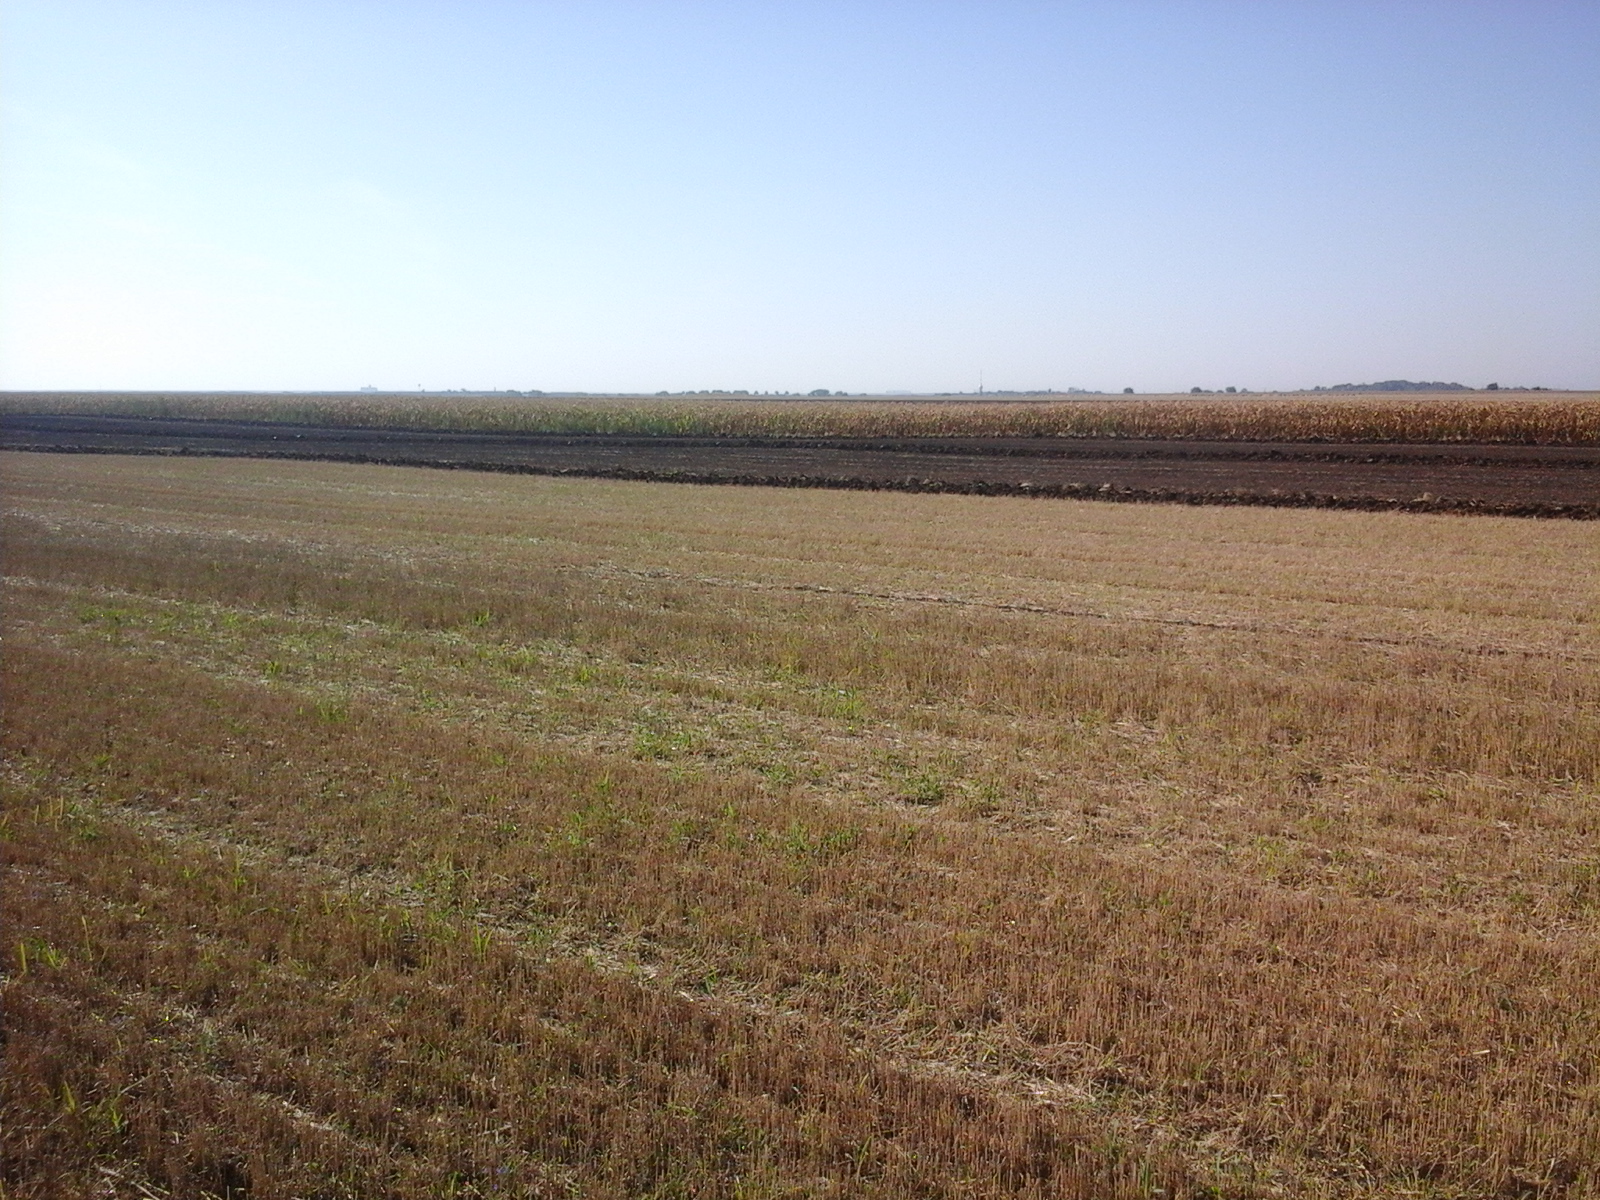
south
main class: Cropland
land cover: Maize
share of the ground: > 75 %
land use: Agriculture (excluding fallow land and kitchen gardens)
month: August
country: RO
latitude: 46.0410
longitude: 21.1310
